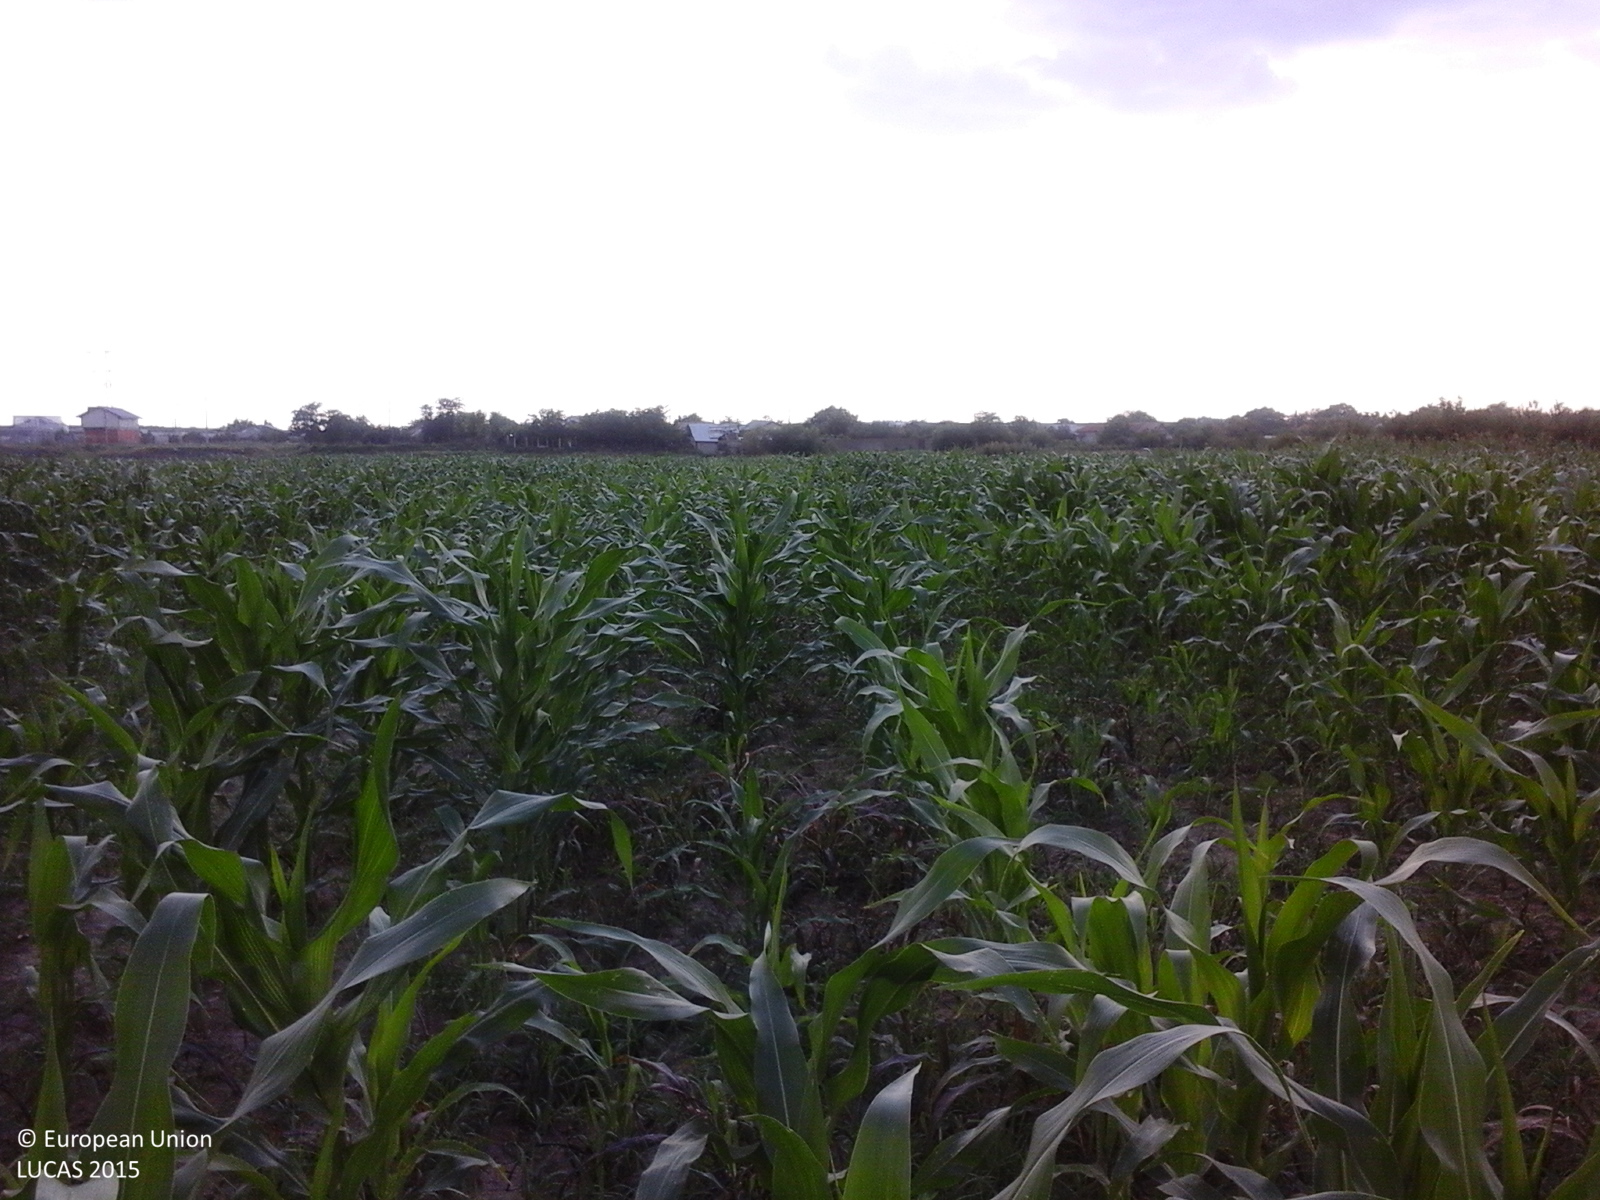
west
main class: Cropland
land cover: Maize
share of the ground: > 75 %
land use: Agriculture (excluding fallow land and kitchen gardens)
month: July
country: RO
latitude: 43.9311
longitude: 25.3673
